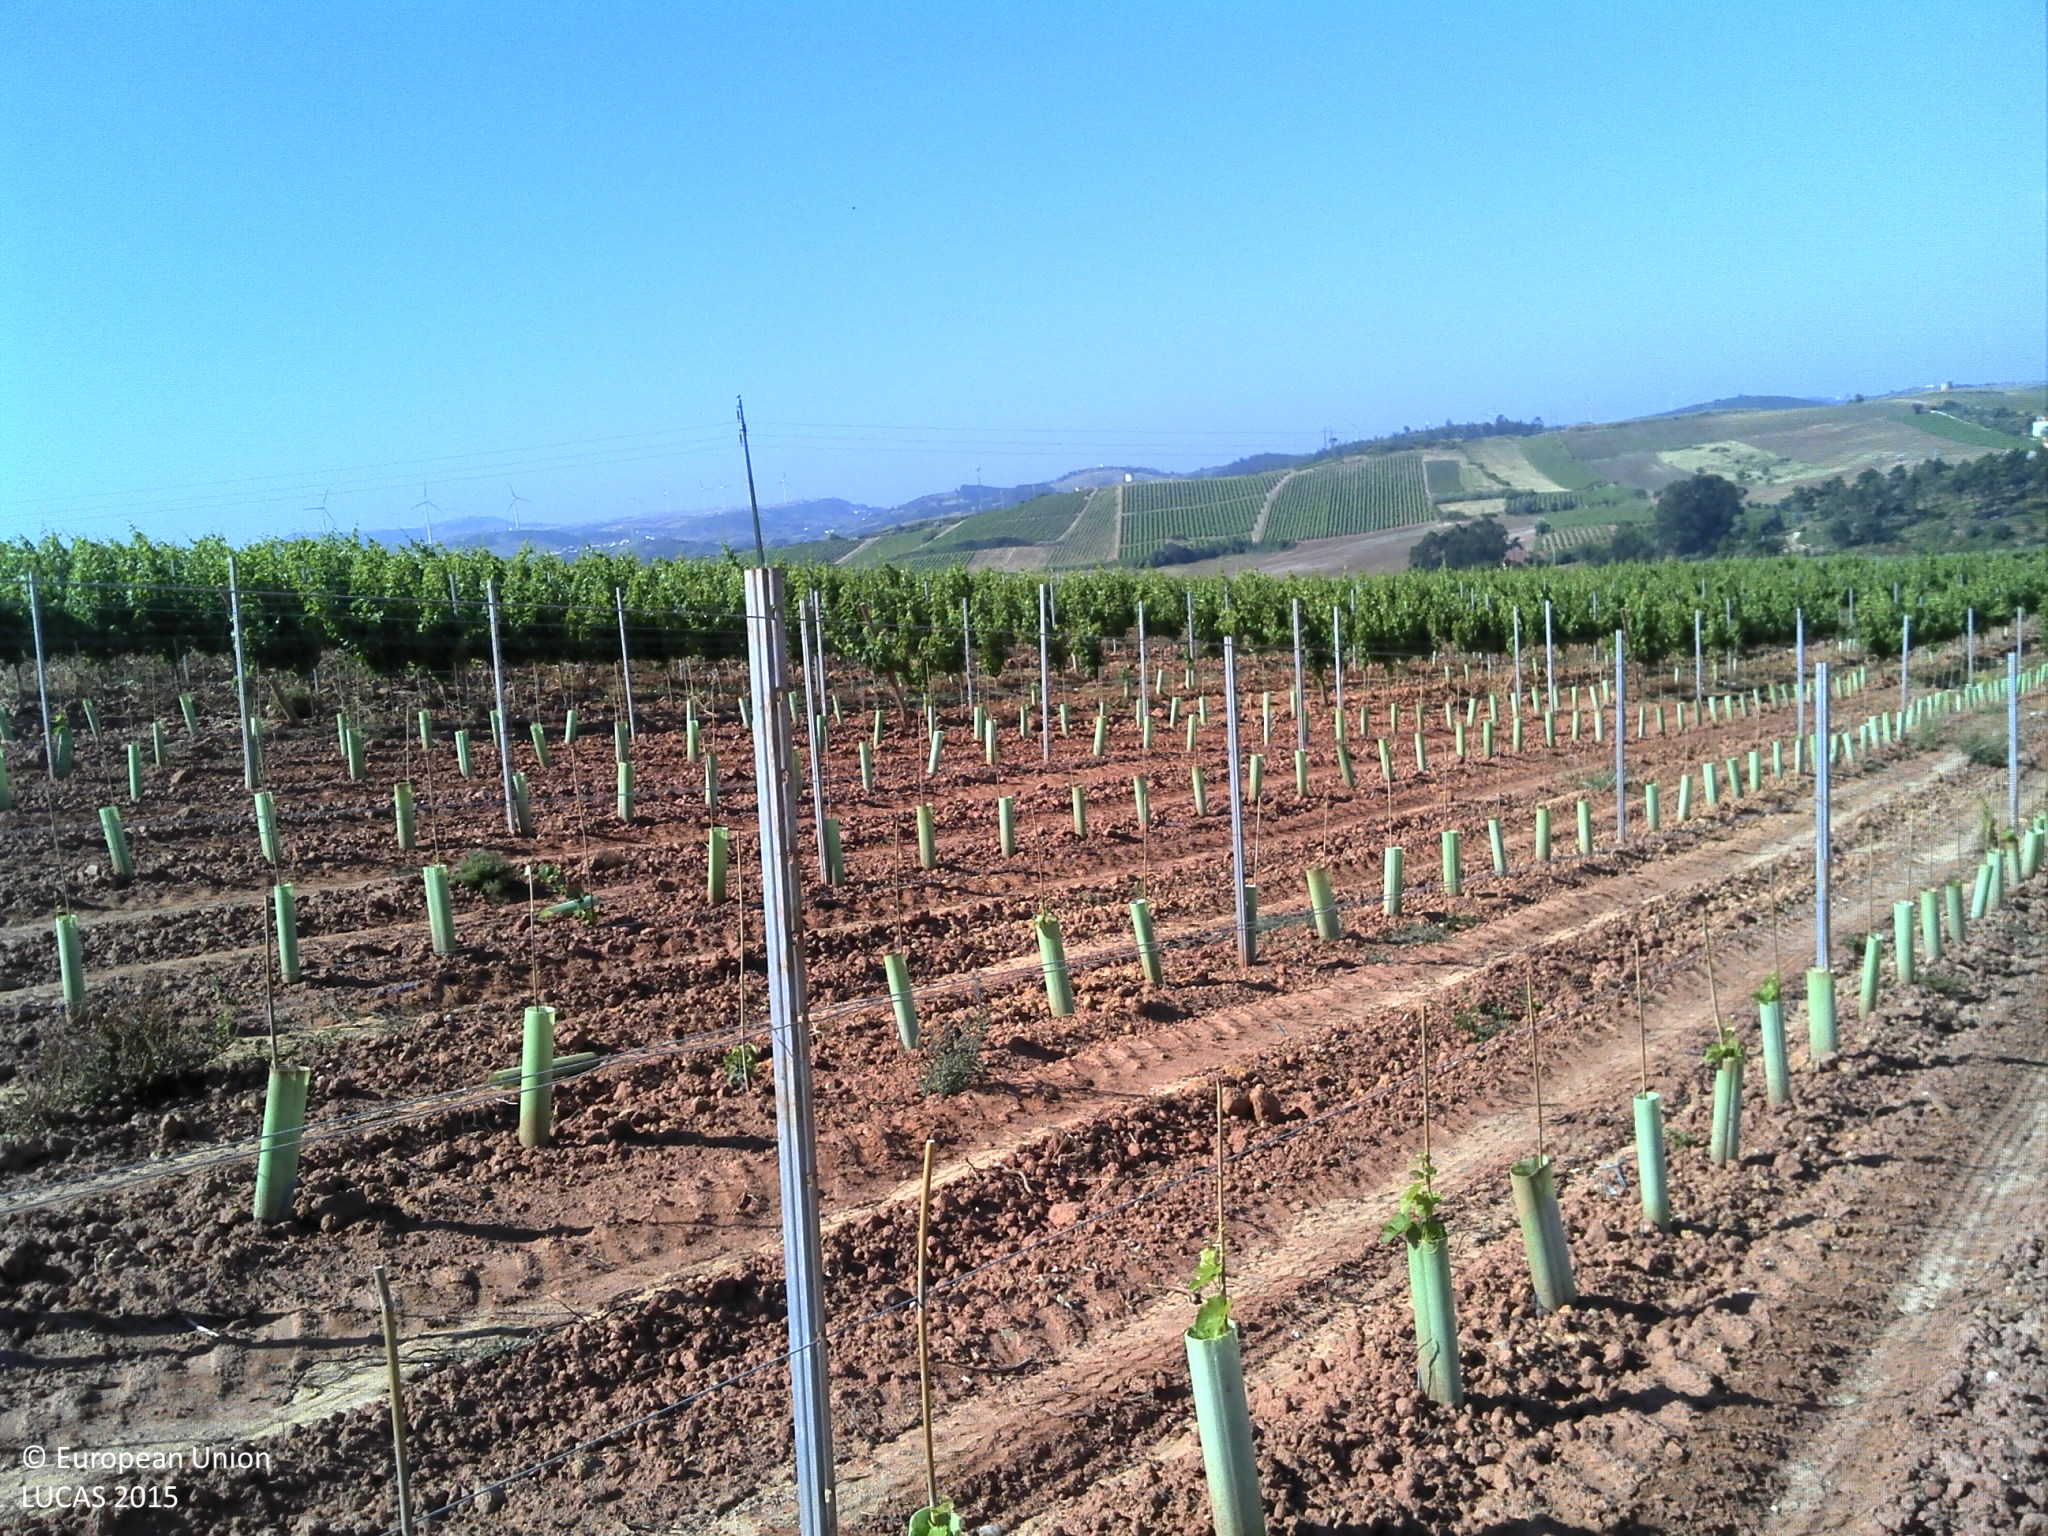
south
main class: Cropland
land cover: Vineyards
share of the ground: < 10 %
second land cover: Other bare soil
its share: > 75 %
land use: Agriculture (excluding fallow land and kitchen gardens)
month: June
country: PT
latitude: 39.1059
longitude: -9.2238
